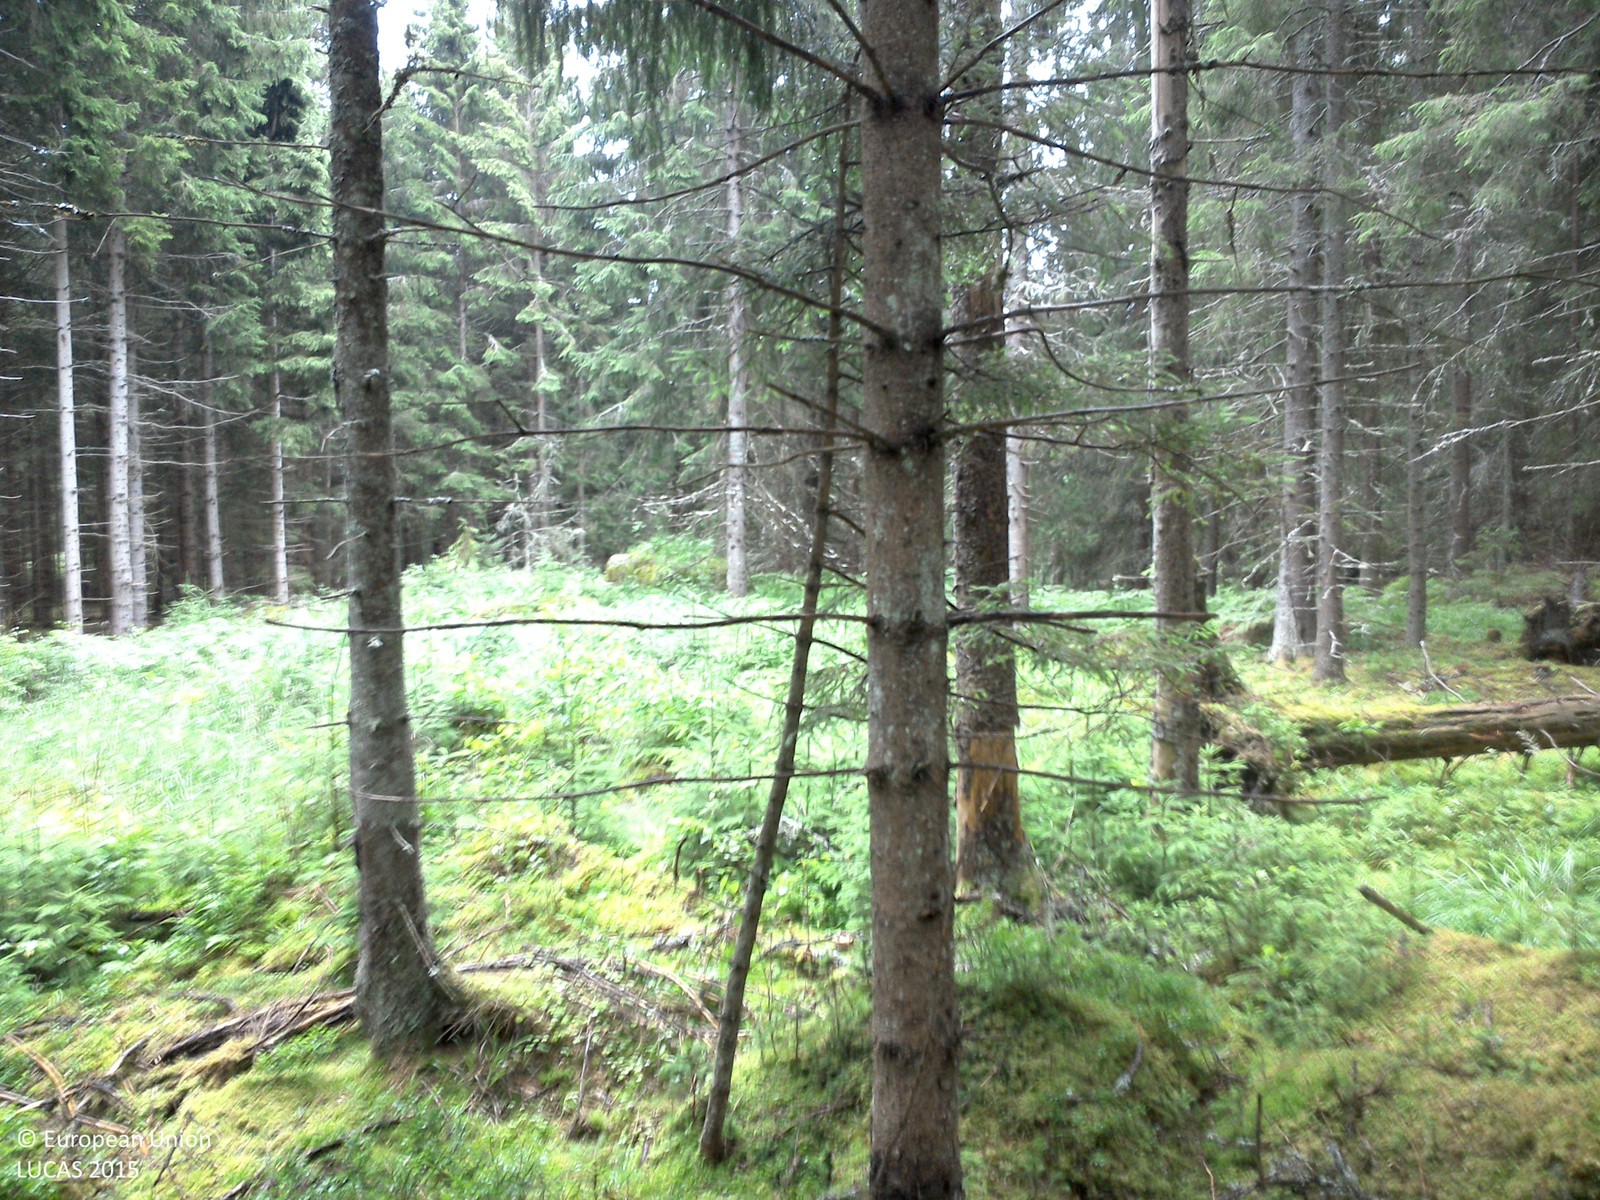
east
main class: Woodland
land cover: Spruce dominated coniferous woodland
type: boreal forest
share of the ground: > 75 %
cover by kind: coniferous forest trees 75 %, lichens and mosses 25 %
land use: Forestry
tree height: > 5 m
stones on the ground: < 10 %
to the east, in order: Spruce dominated coniferous woodland; Ditches and canals; Spruce dominated coniferous woodland; Ditches and canals; Spruce dominated coniferous woodland; Paved roads, cycling and walking lanes; Spruce dominated mixed woodland; Spruce dominated coniferous woodland; Ditches and canals; Spruce dominated coniferous woodland; Other bare soil
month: July
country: SE
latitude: 57.8162
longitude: 15.9726
